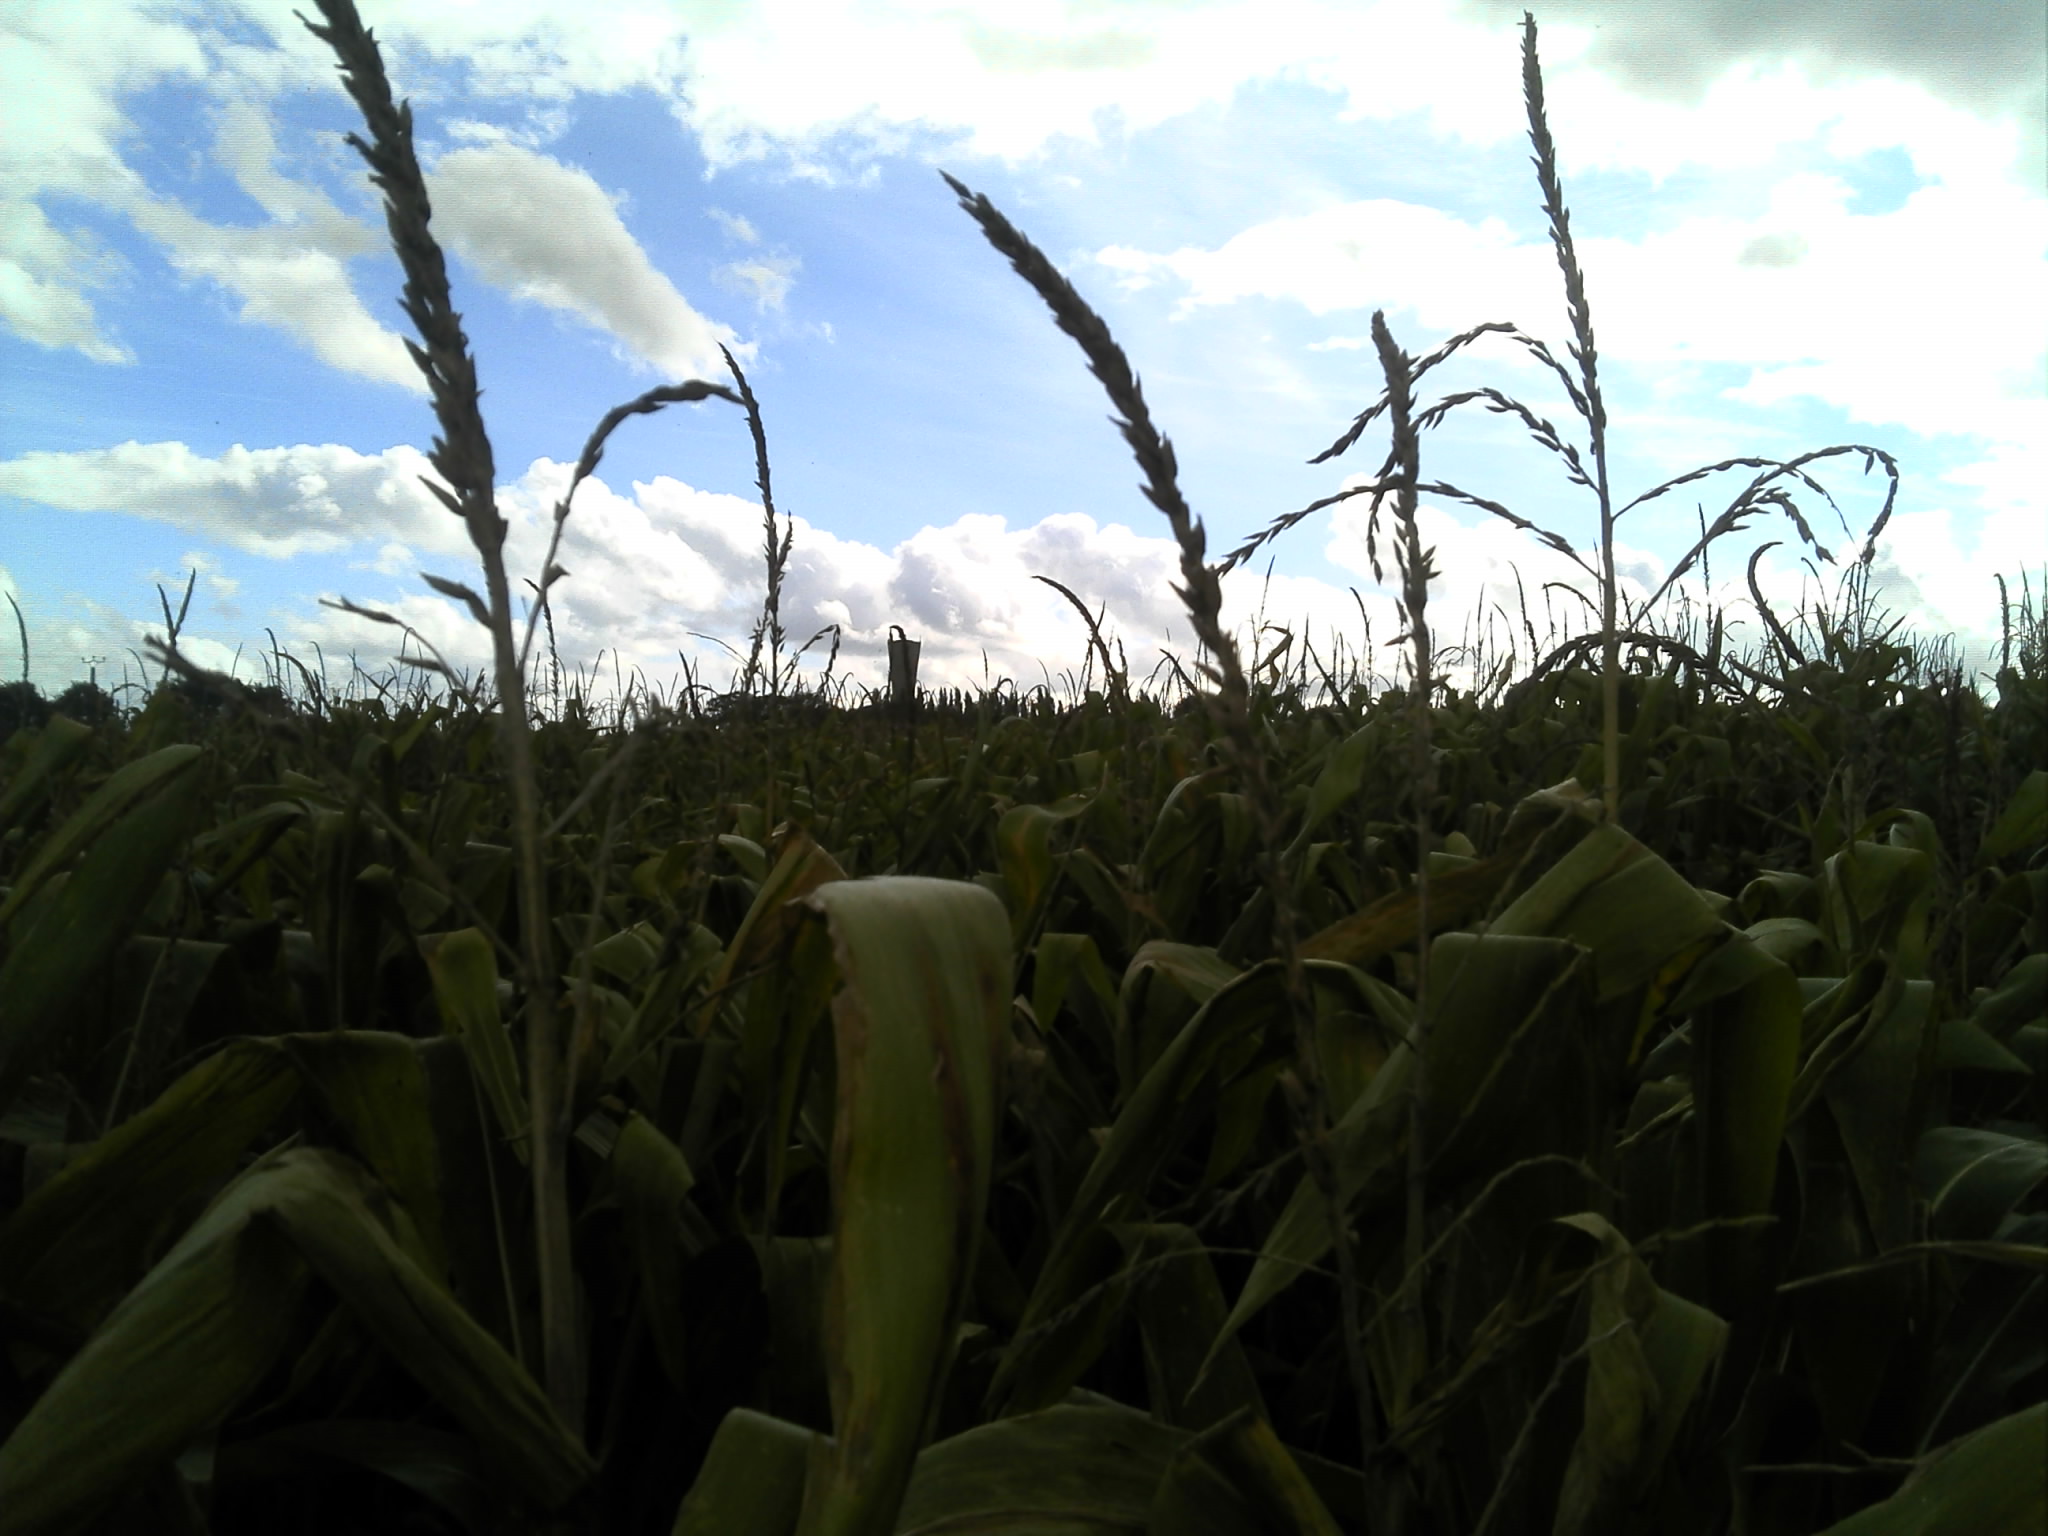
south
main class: Cropland
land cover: Maize
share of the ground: > 75 %
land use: Agriculture (excluding fallow land and kitchen gardens)
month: October
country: FR
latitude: 47.7673
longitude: -1.1273
